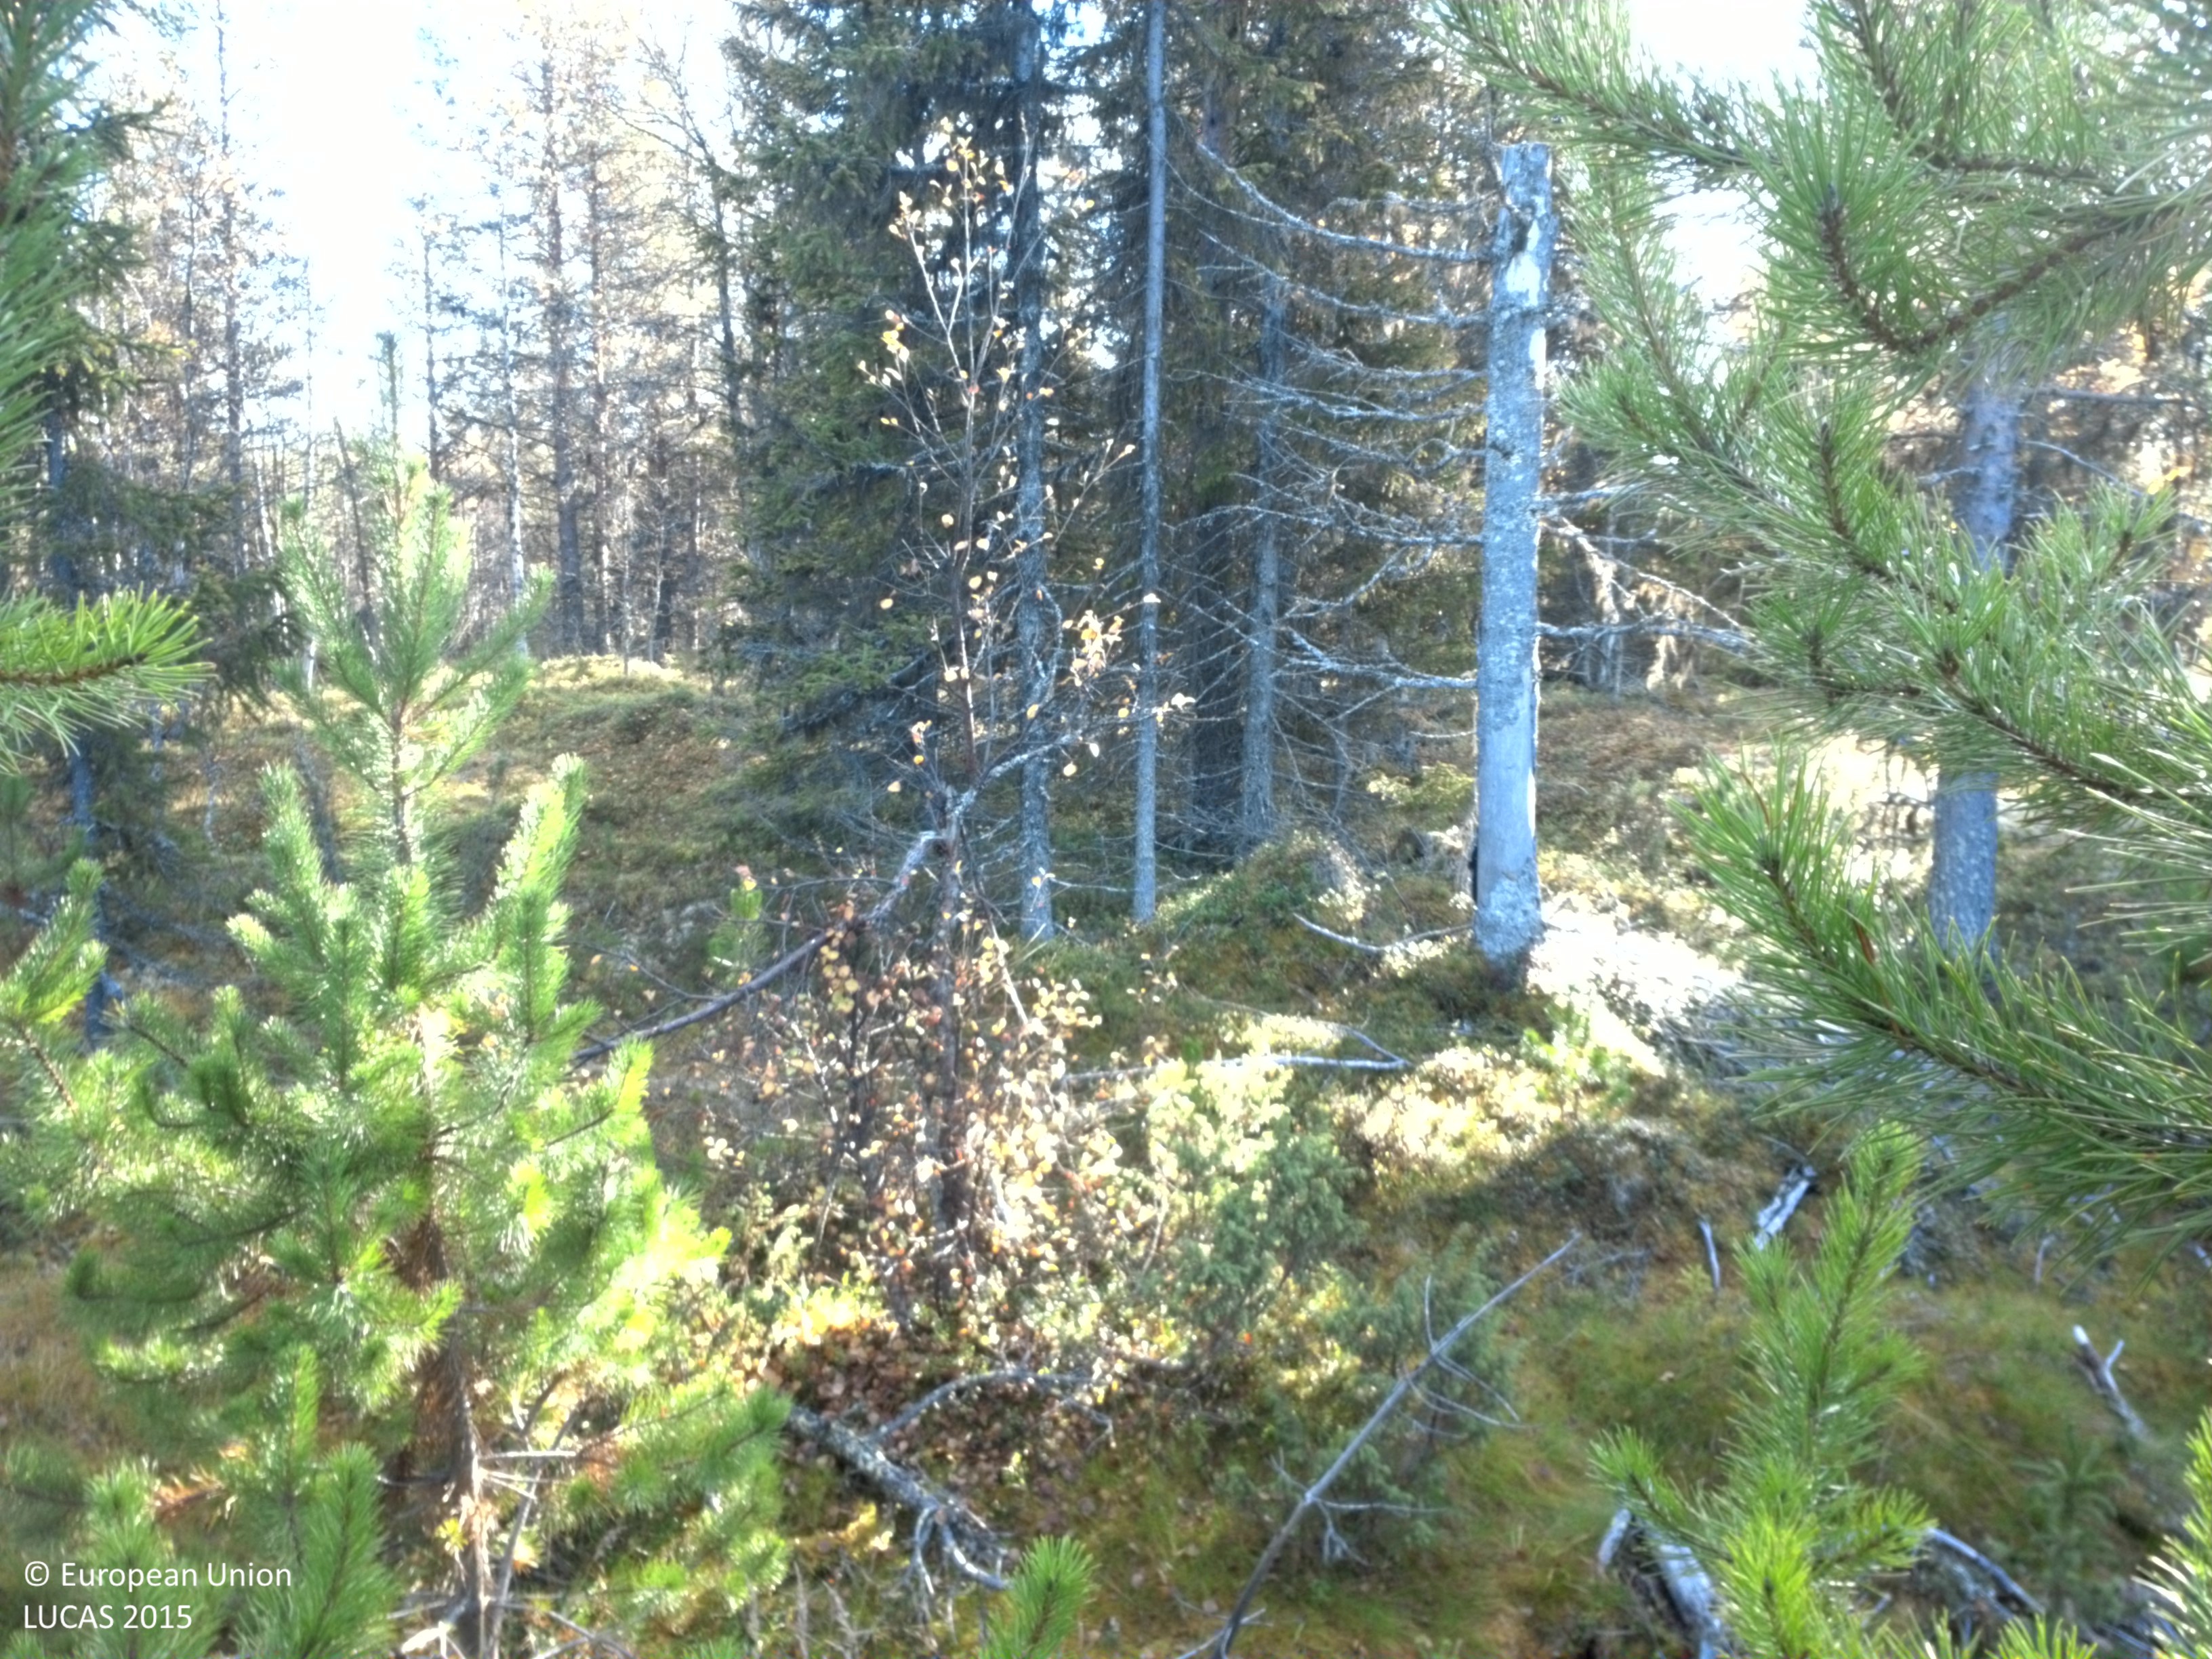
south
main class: Woodland
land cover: Pine dominated coniferous woodland
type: exotic forest
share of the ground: 25 - 50 %
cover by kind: coniferous forest trees 55 %, lichens and mosses 25 %, shrubs 10 %, herbaceous plants 10 %
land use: Forestry
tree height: < 5 m
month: September
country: SE
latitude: 64.8884
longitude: 17.5882
